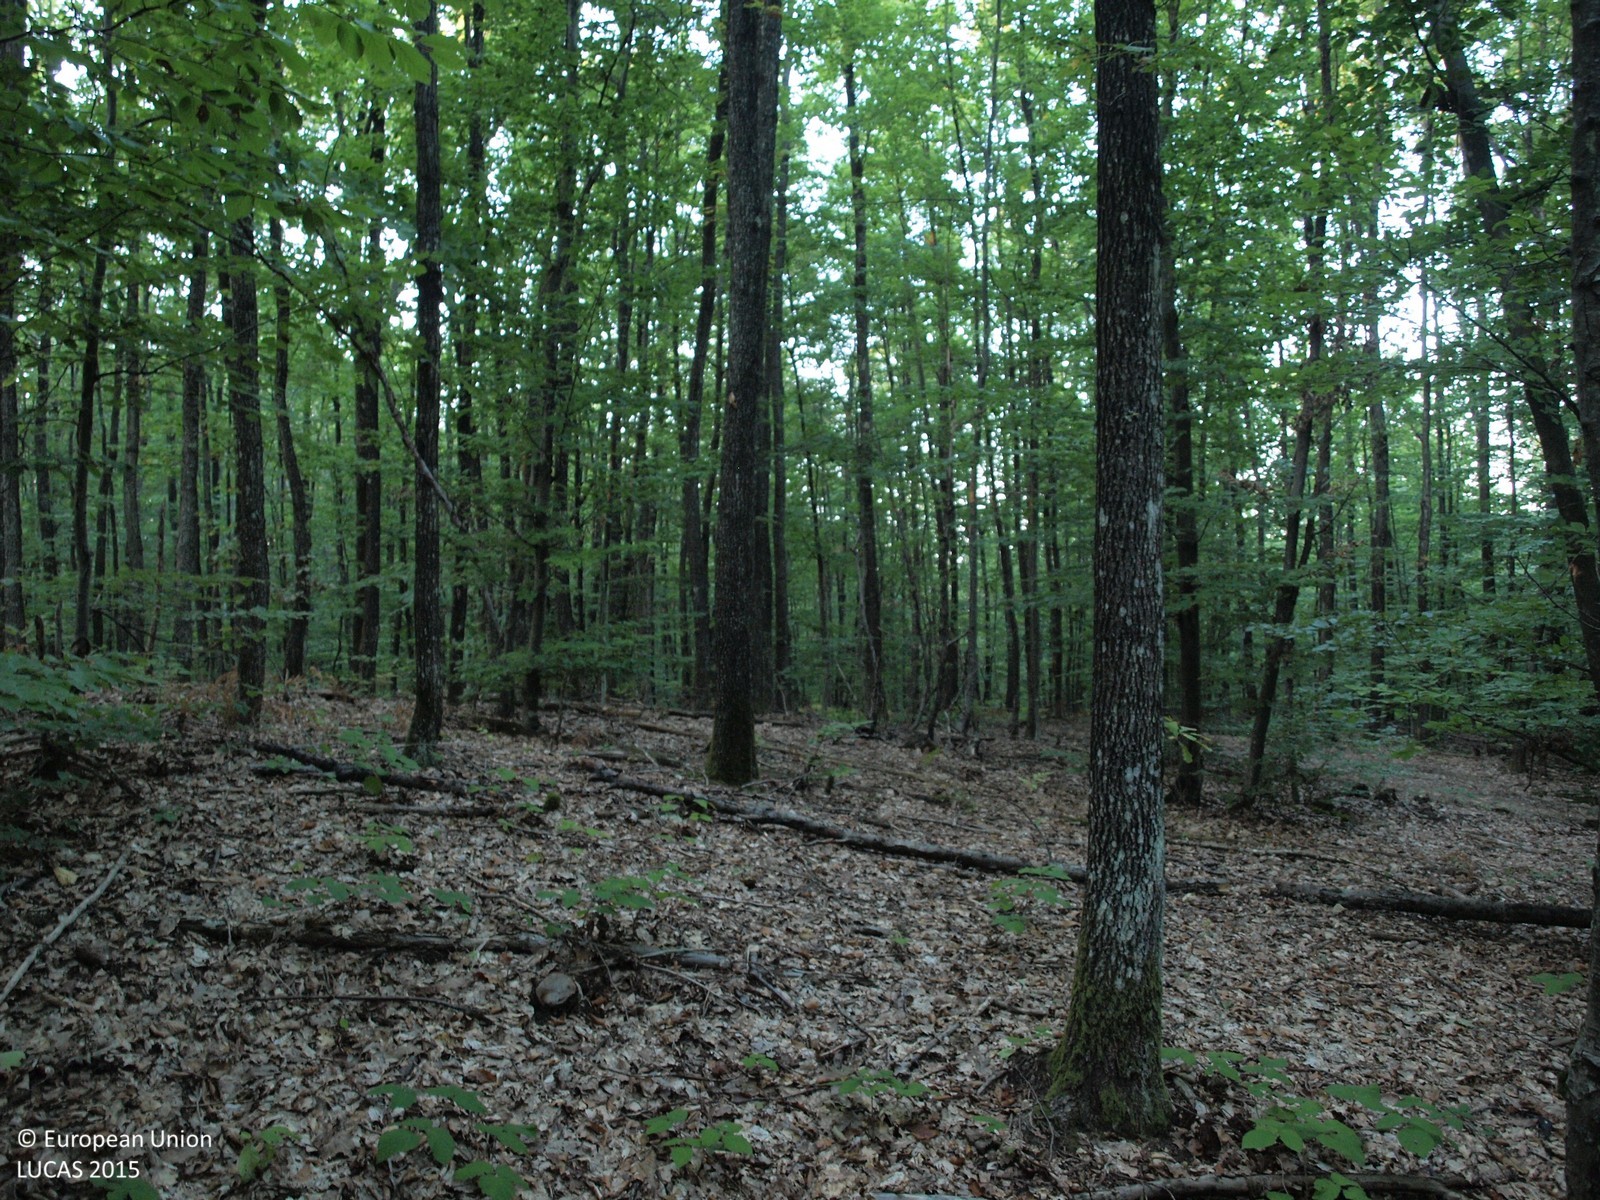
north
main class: Woodland
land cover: Broadleaved woodland
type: mesophytic deciduous forest
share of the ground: > 75 %
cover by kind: broadleaved forest trees 100 %
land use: Forestry
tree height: > 5 m
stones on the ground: < 10 %
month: September
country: HR
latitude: 45.5294
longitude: 16.0537
